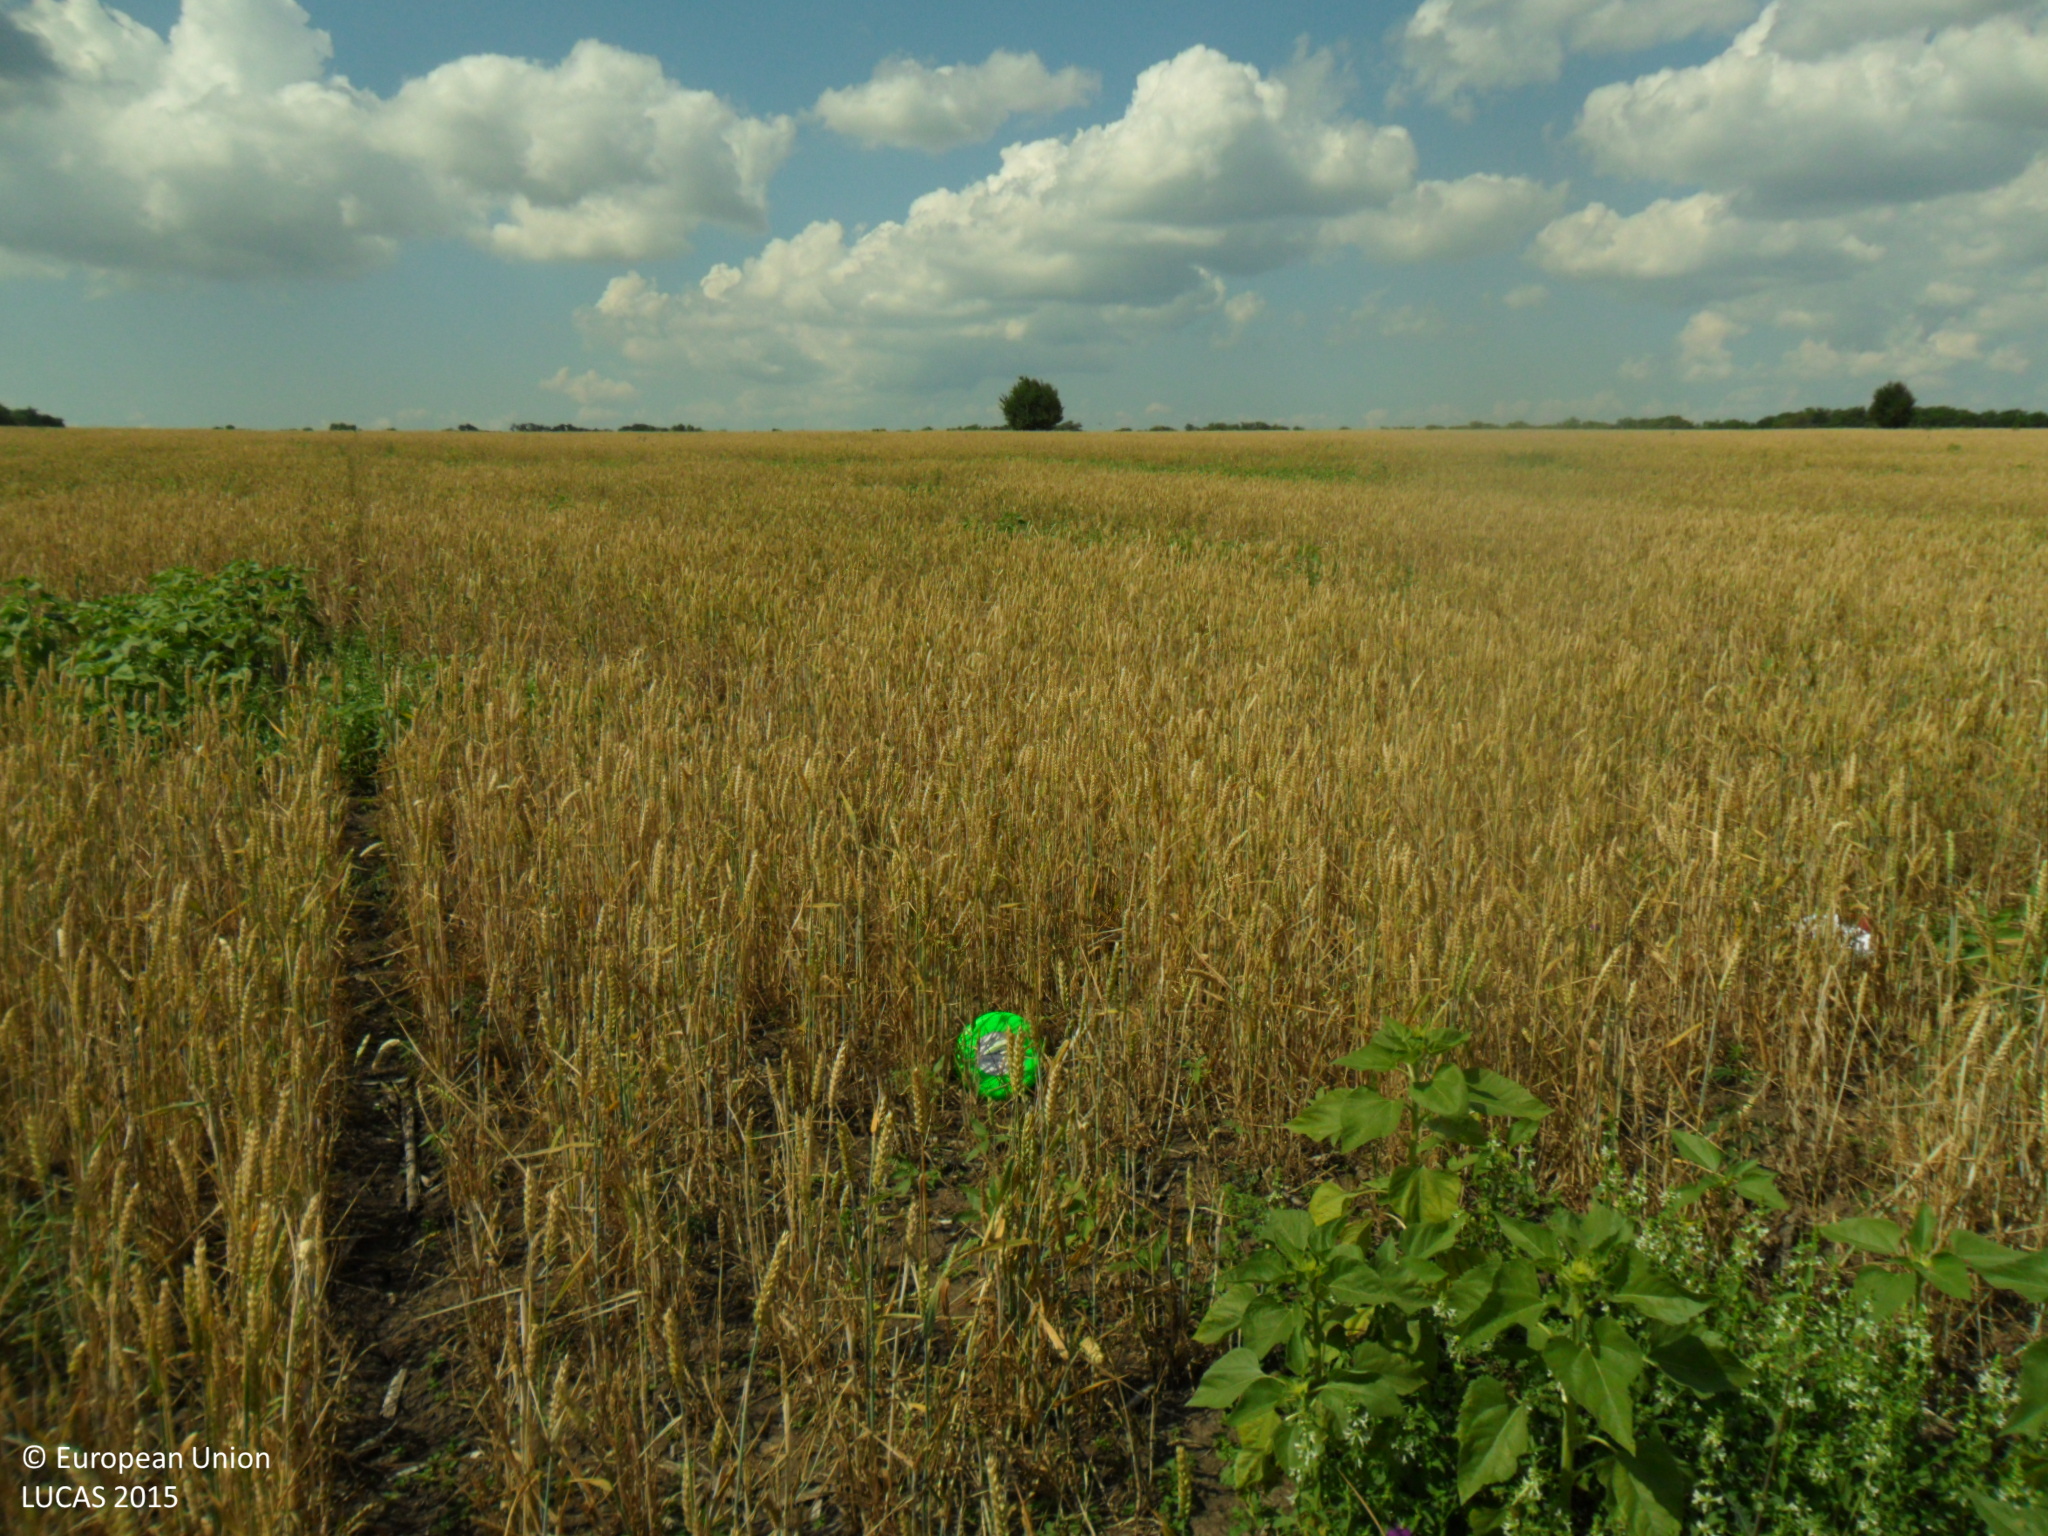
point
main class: Cropland
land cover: Common wheat
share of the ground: > 75 %
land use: Agriculture (excluding fallow land and kitchen gardens)
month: June
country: BG
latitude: 43.3573
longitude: 27.0072
